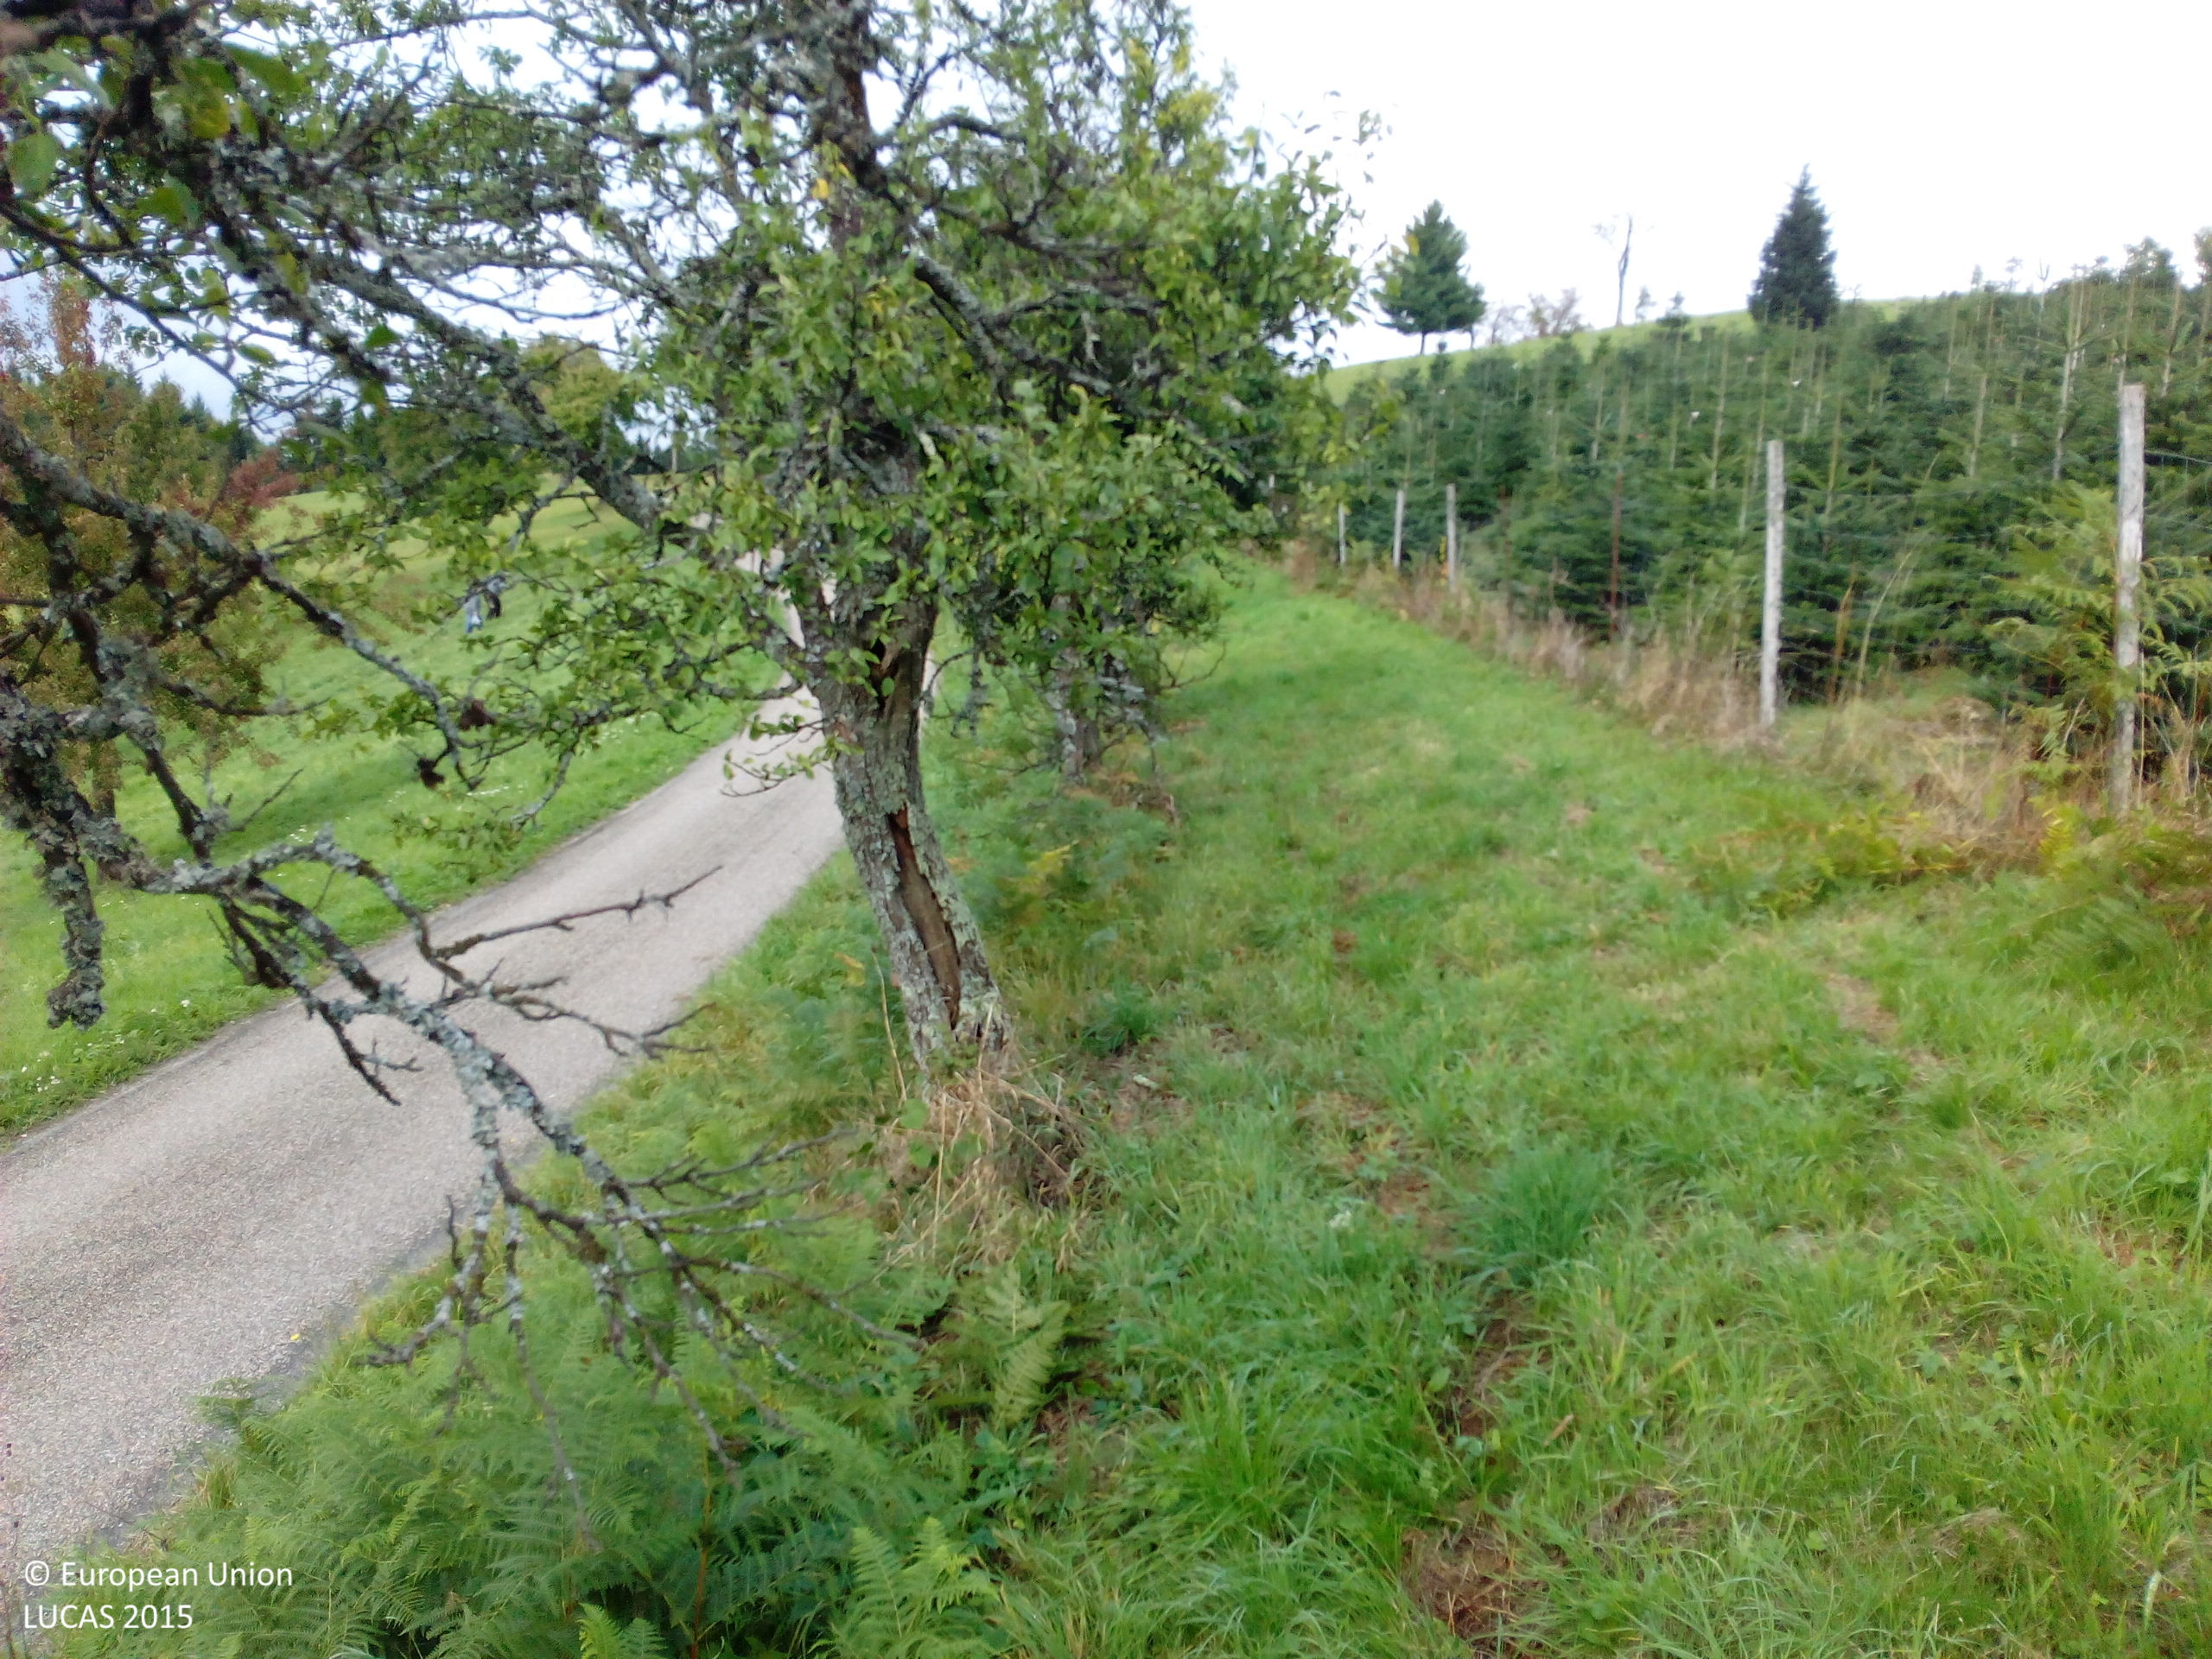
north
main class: Cropland
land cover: Other fruit trees and berries
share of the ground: 10 - 25 %
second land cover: Grassland without tree/shrub cover
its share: > 75 %
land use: Agriculture (excluding fallow land and kitchen gardens)
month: September
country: DE
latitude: 48.3332
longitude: 8.0989
